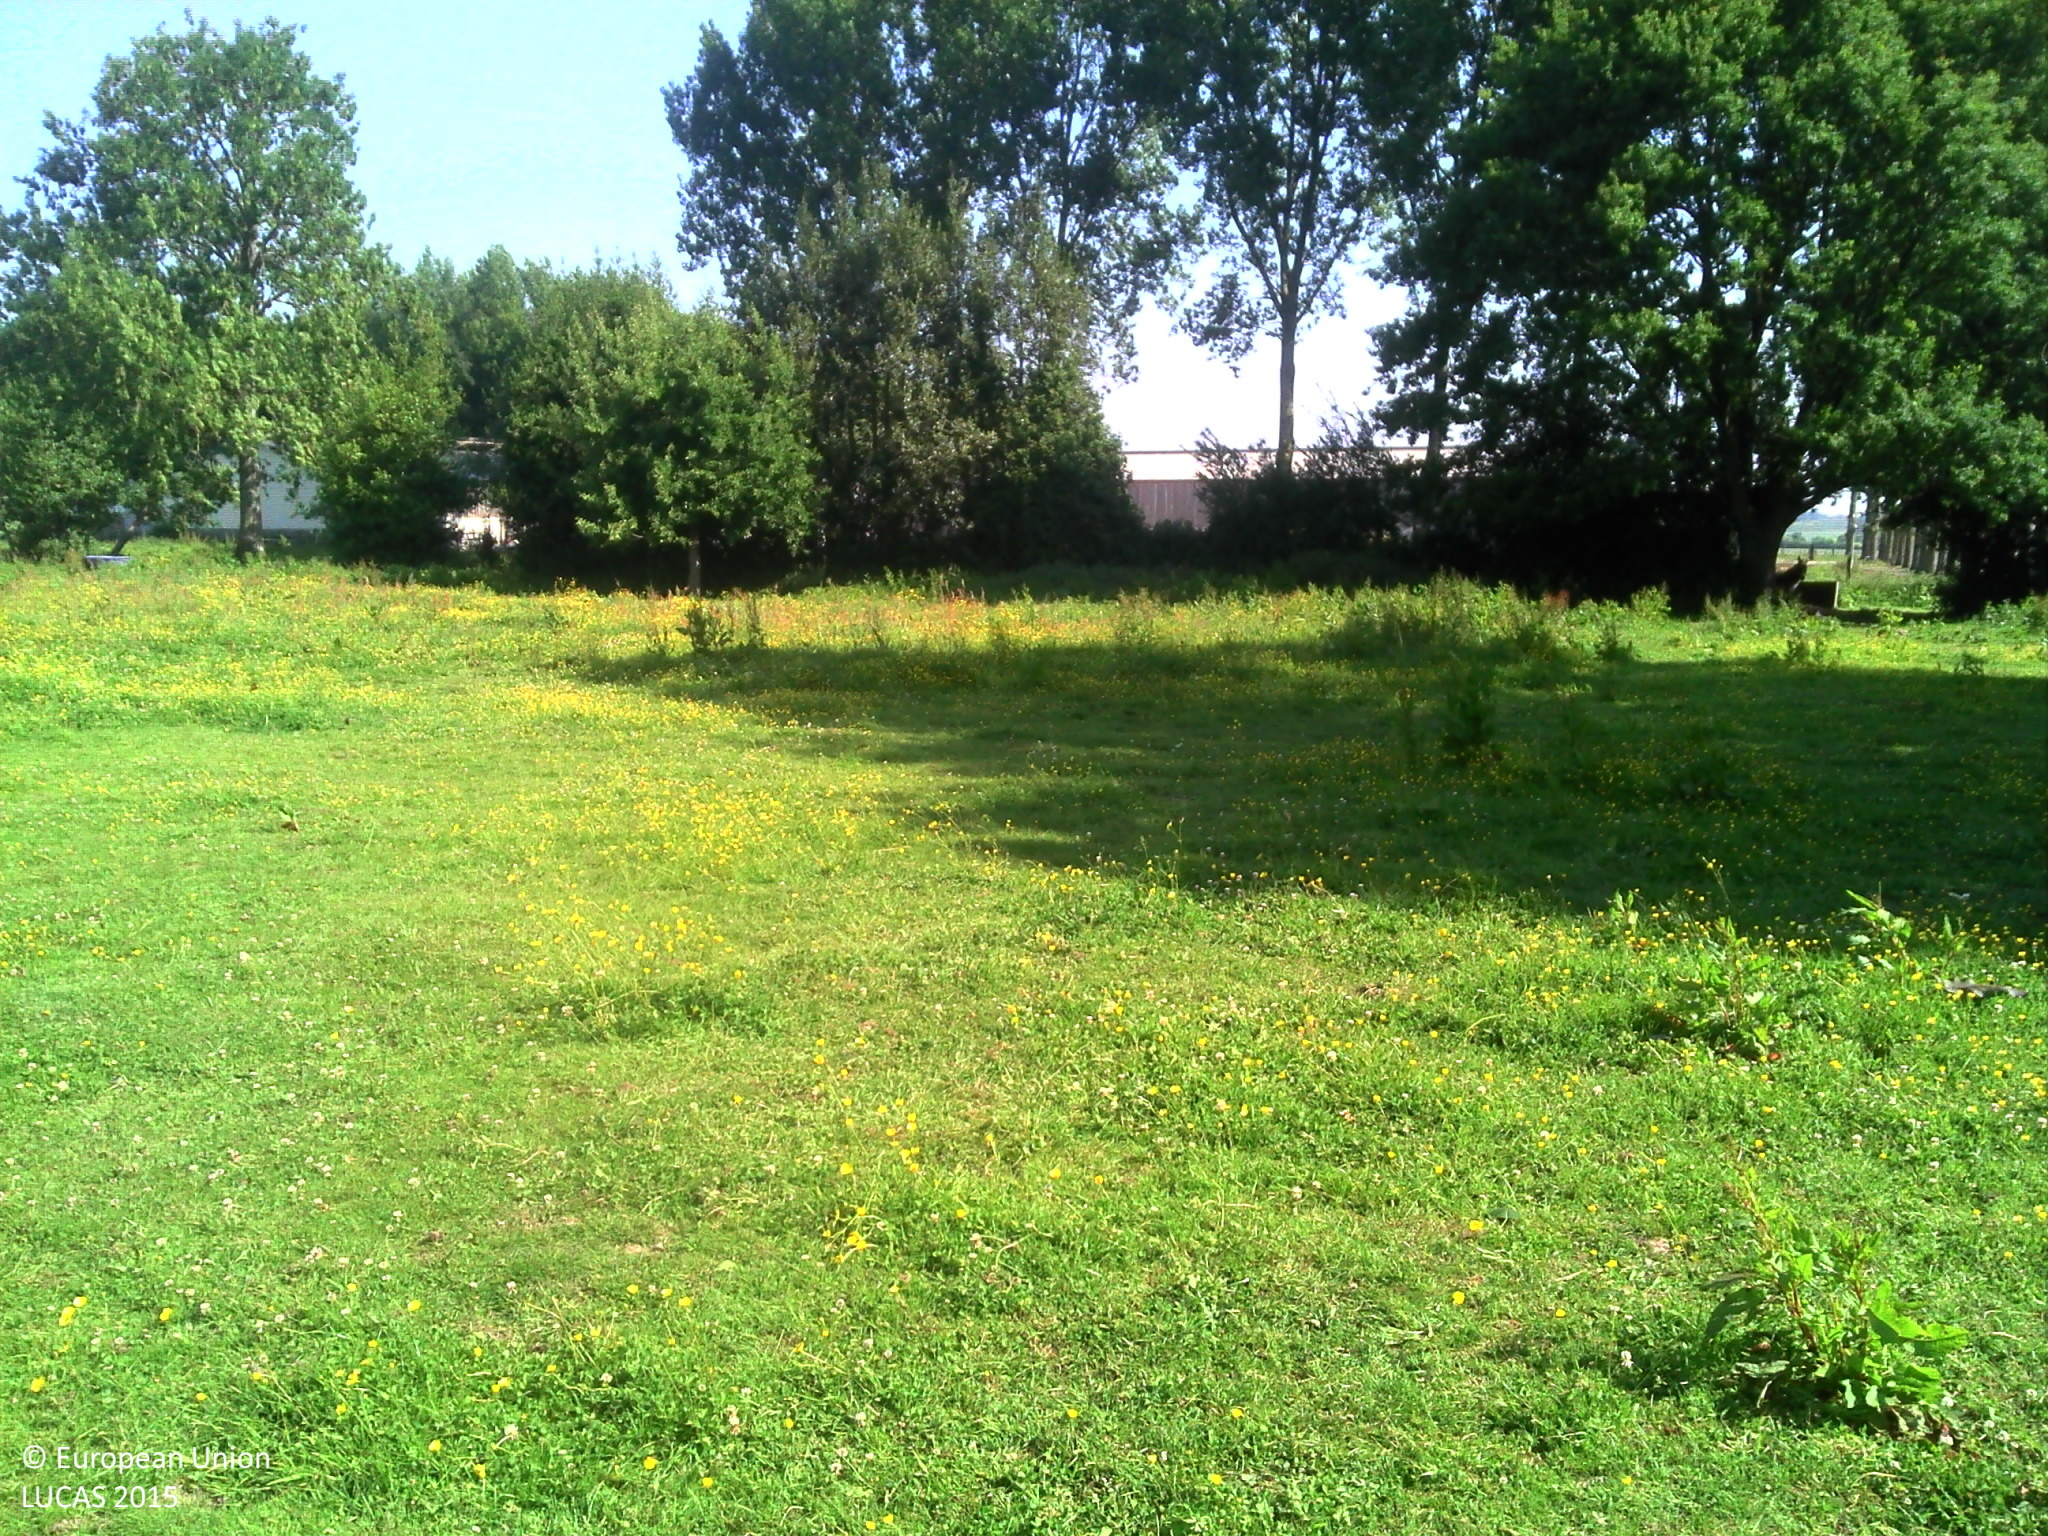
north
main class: Grassland
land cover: Grassland without tree/shrub cover
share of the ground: > 75 %
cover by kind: herbaceous plants 100 %
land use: Agriculture (excluding fallow land and kitchen gardens)
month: June
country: FR
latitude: 49.9885
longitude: 1.6835
